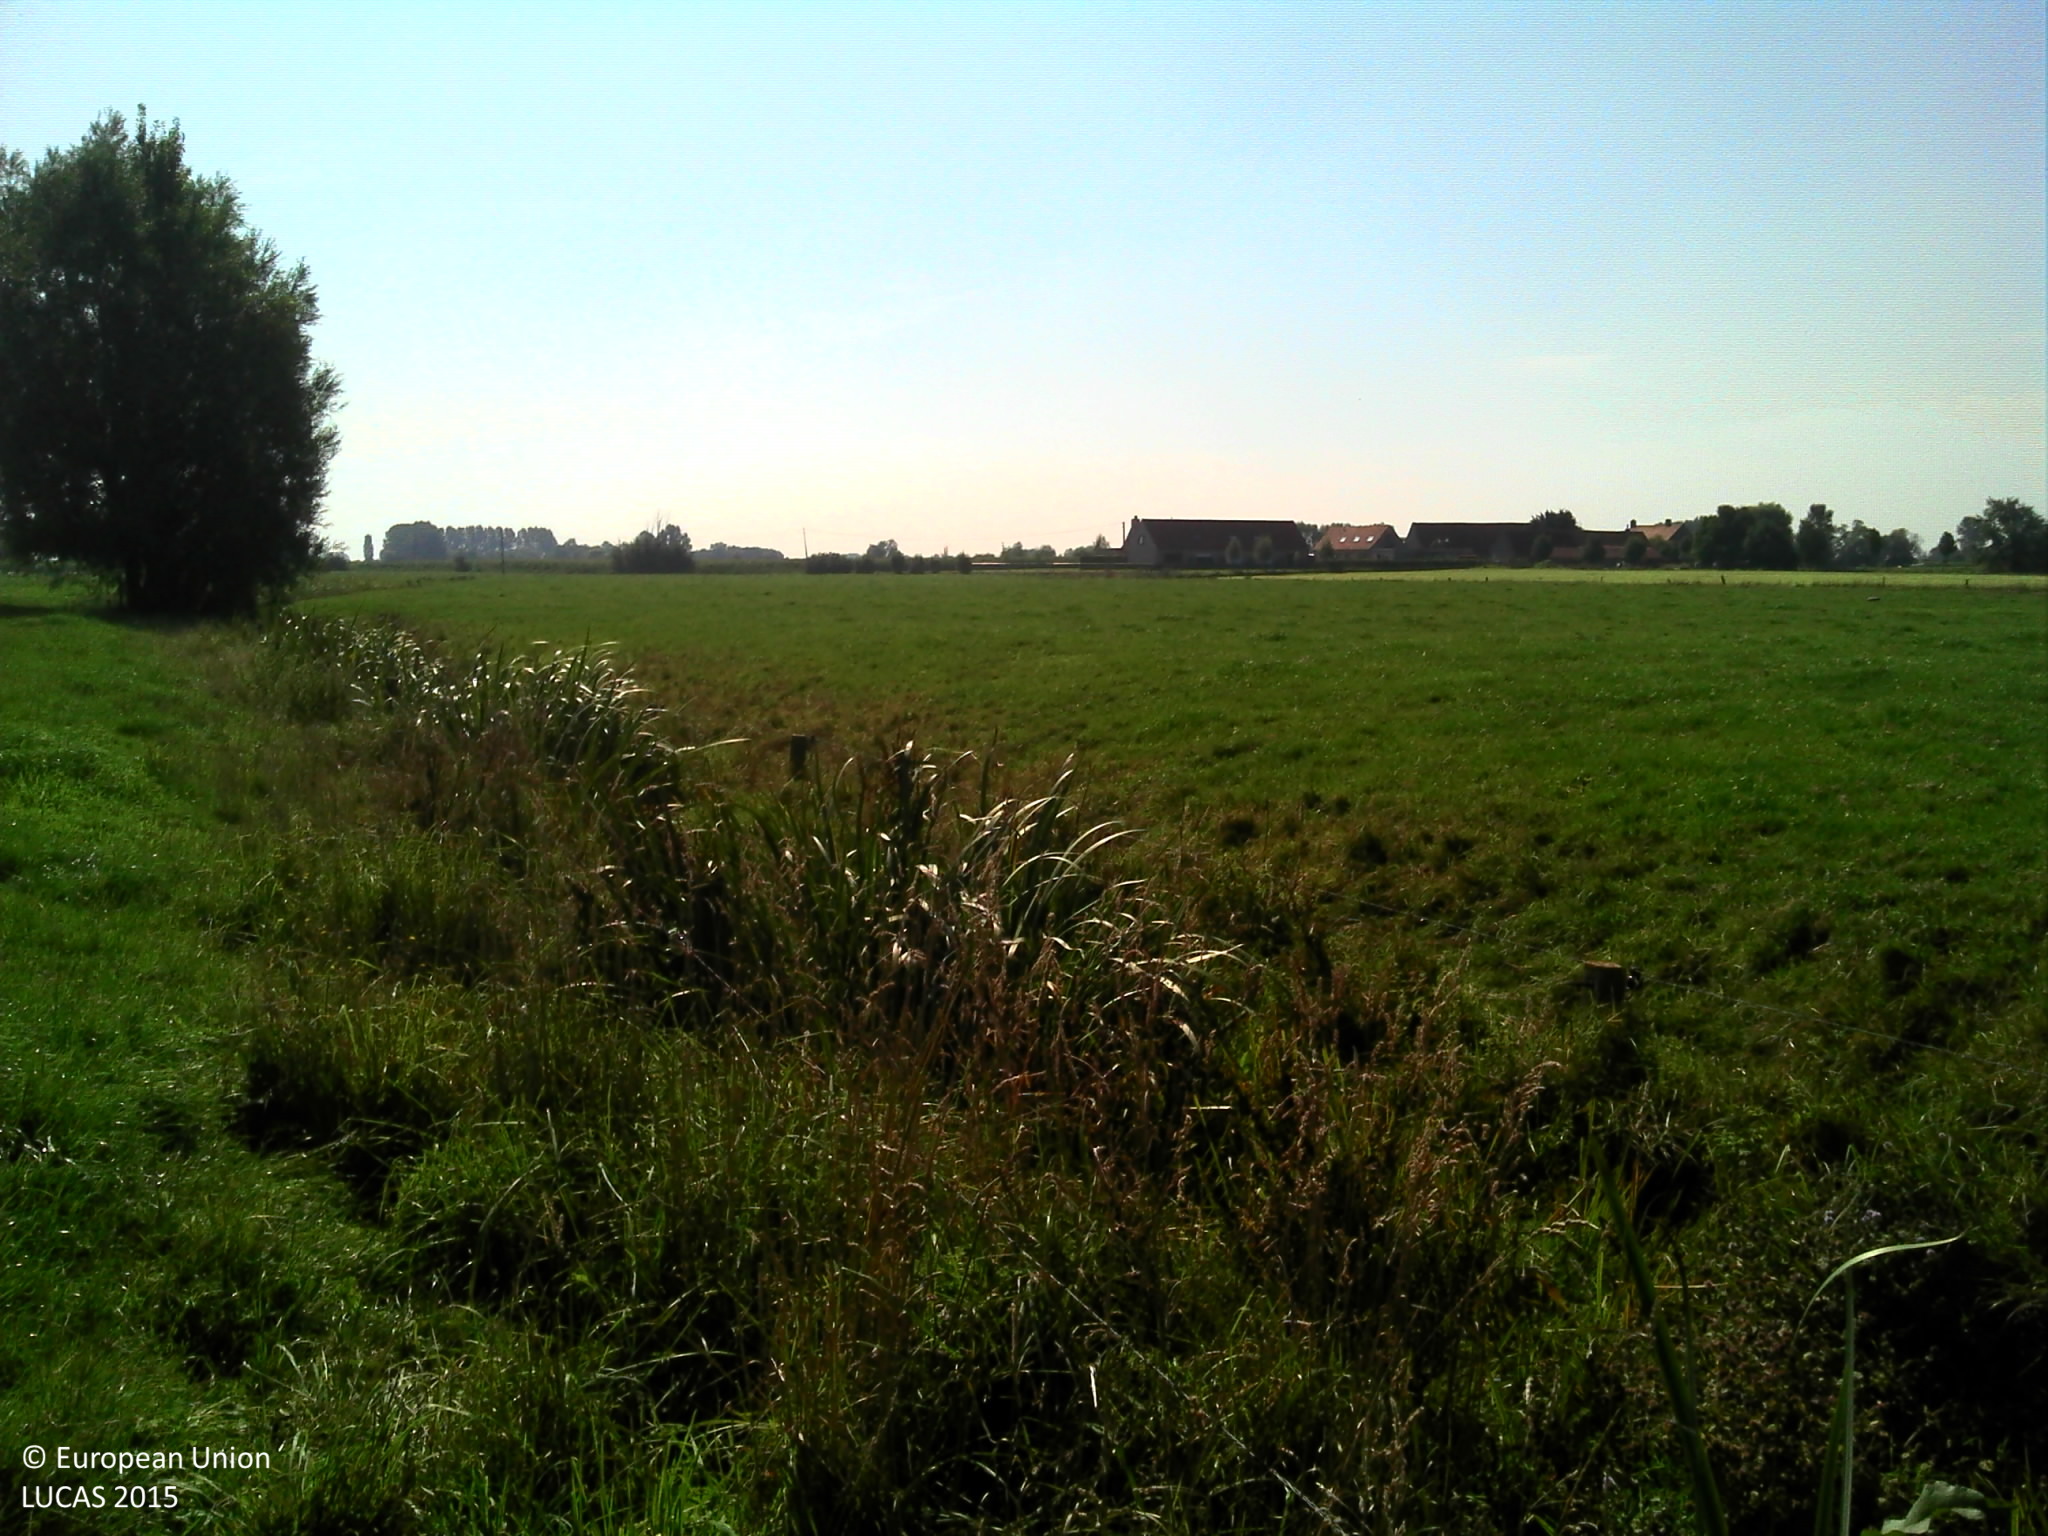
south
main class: Grassland
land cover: Grassland without tree/shrub cover
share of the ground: > 75 %
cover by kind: herbaceous plants 100 %
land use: Agriculture (excluding fallow land and kitchen gardens)
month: September
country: BE
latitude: 51.0031
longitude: 2.7922
